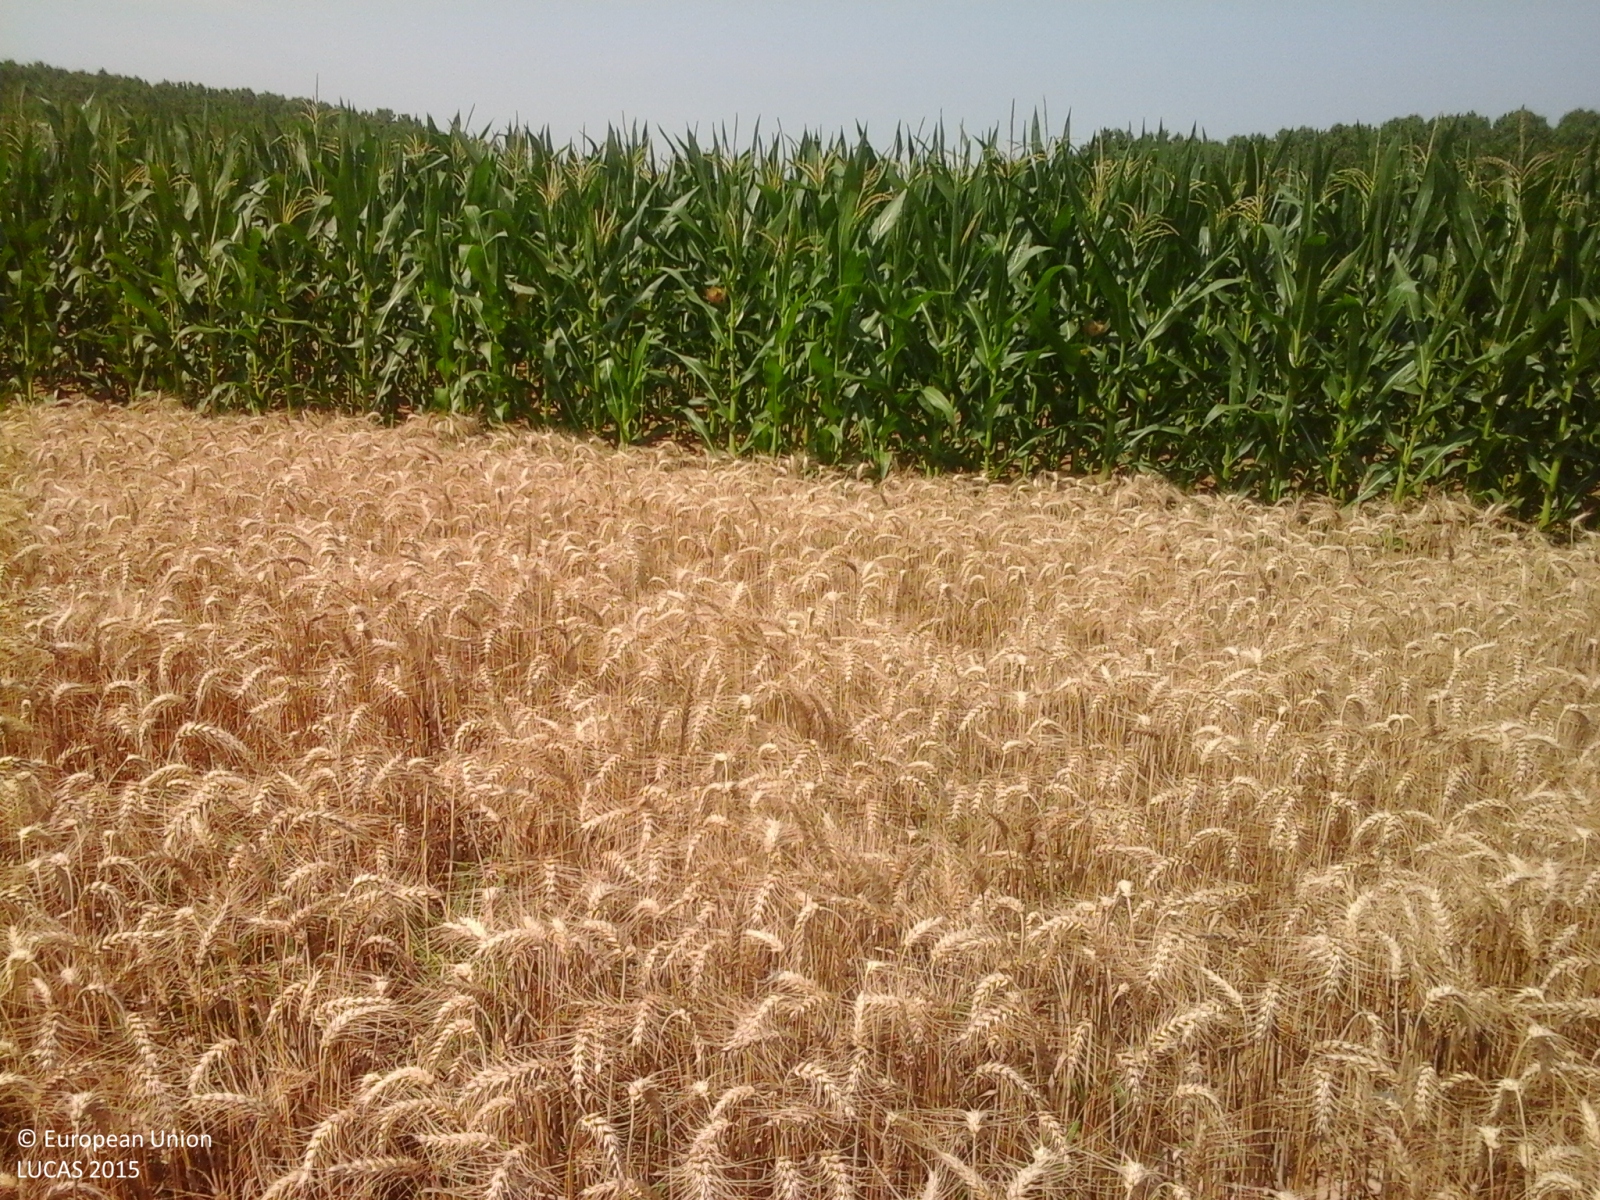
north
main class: Cropland
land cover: Common wheat
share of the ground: > 75 %
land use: Agriculture (excluding fallow land and kitchen gardens)
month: June
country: IT
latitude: 45.0253
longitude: 8.5179
